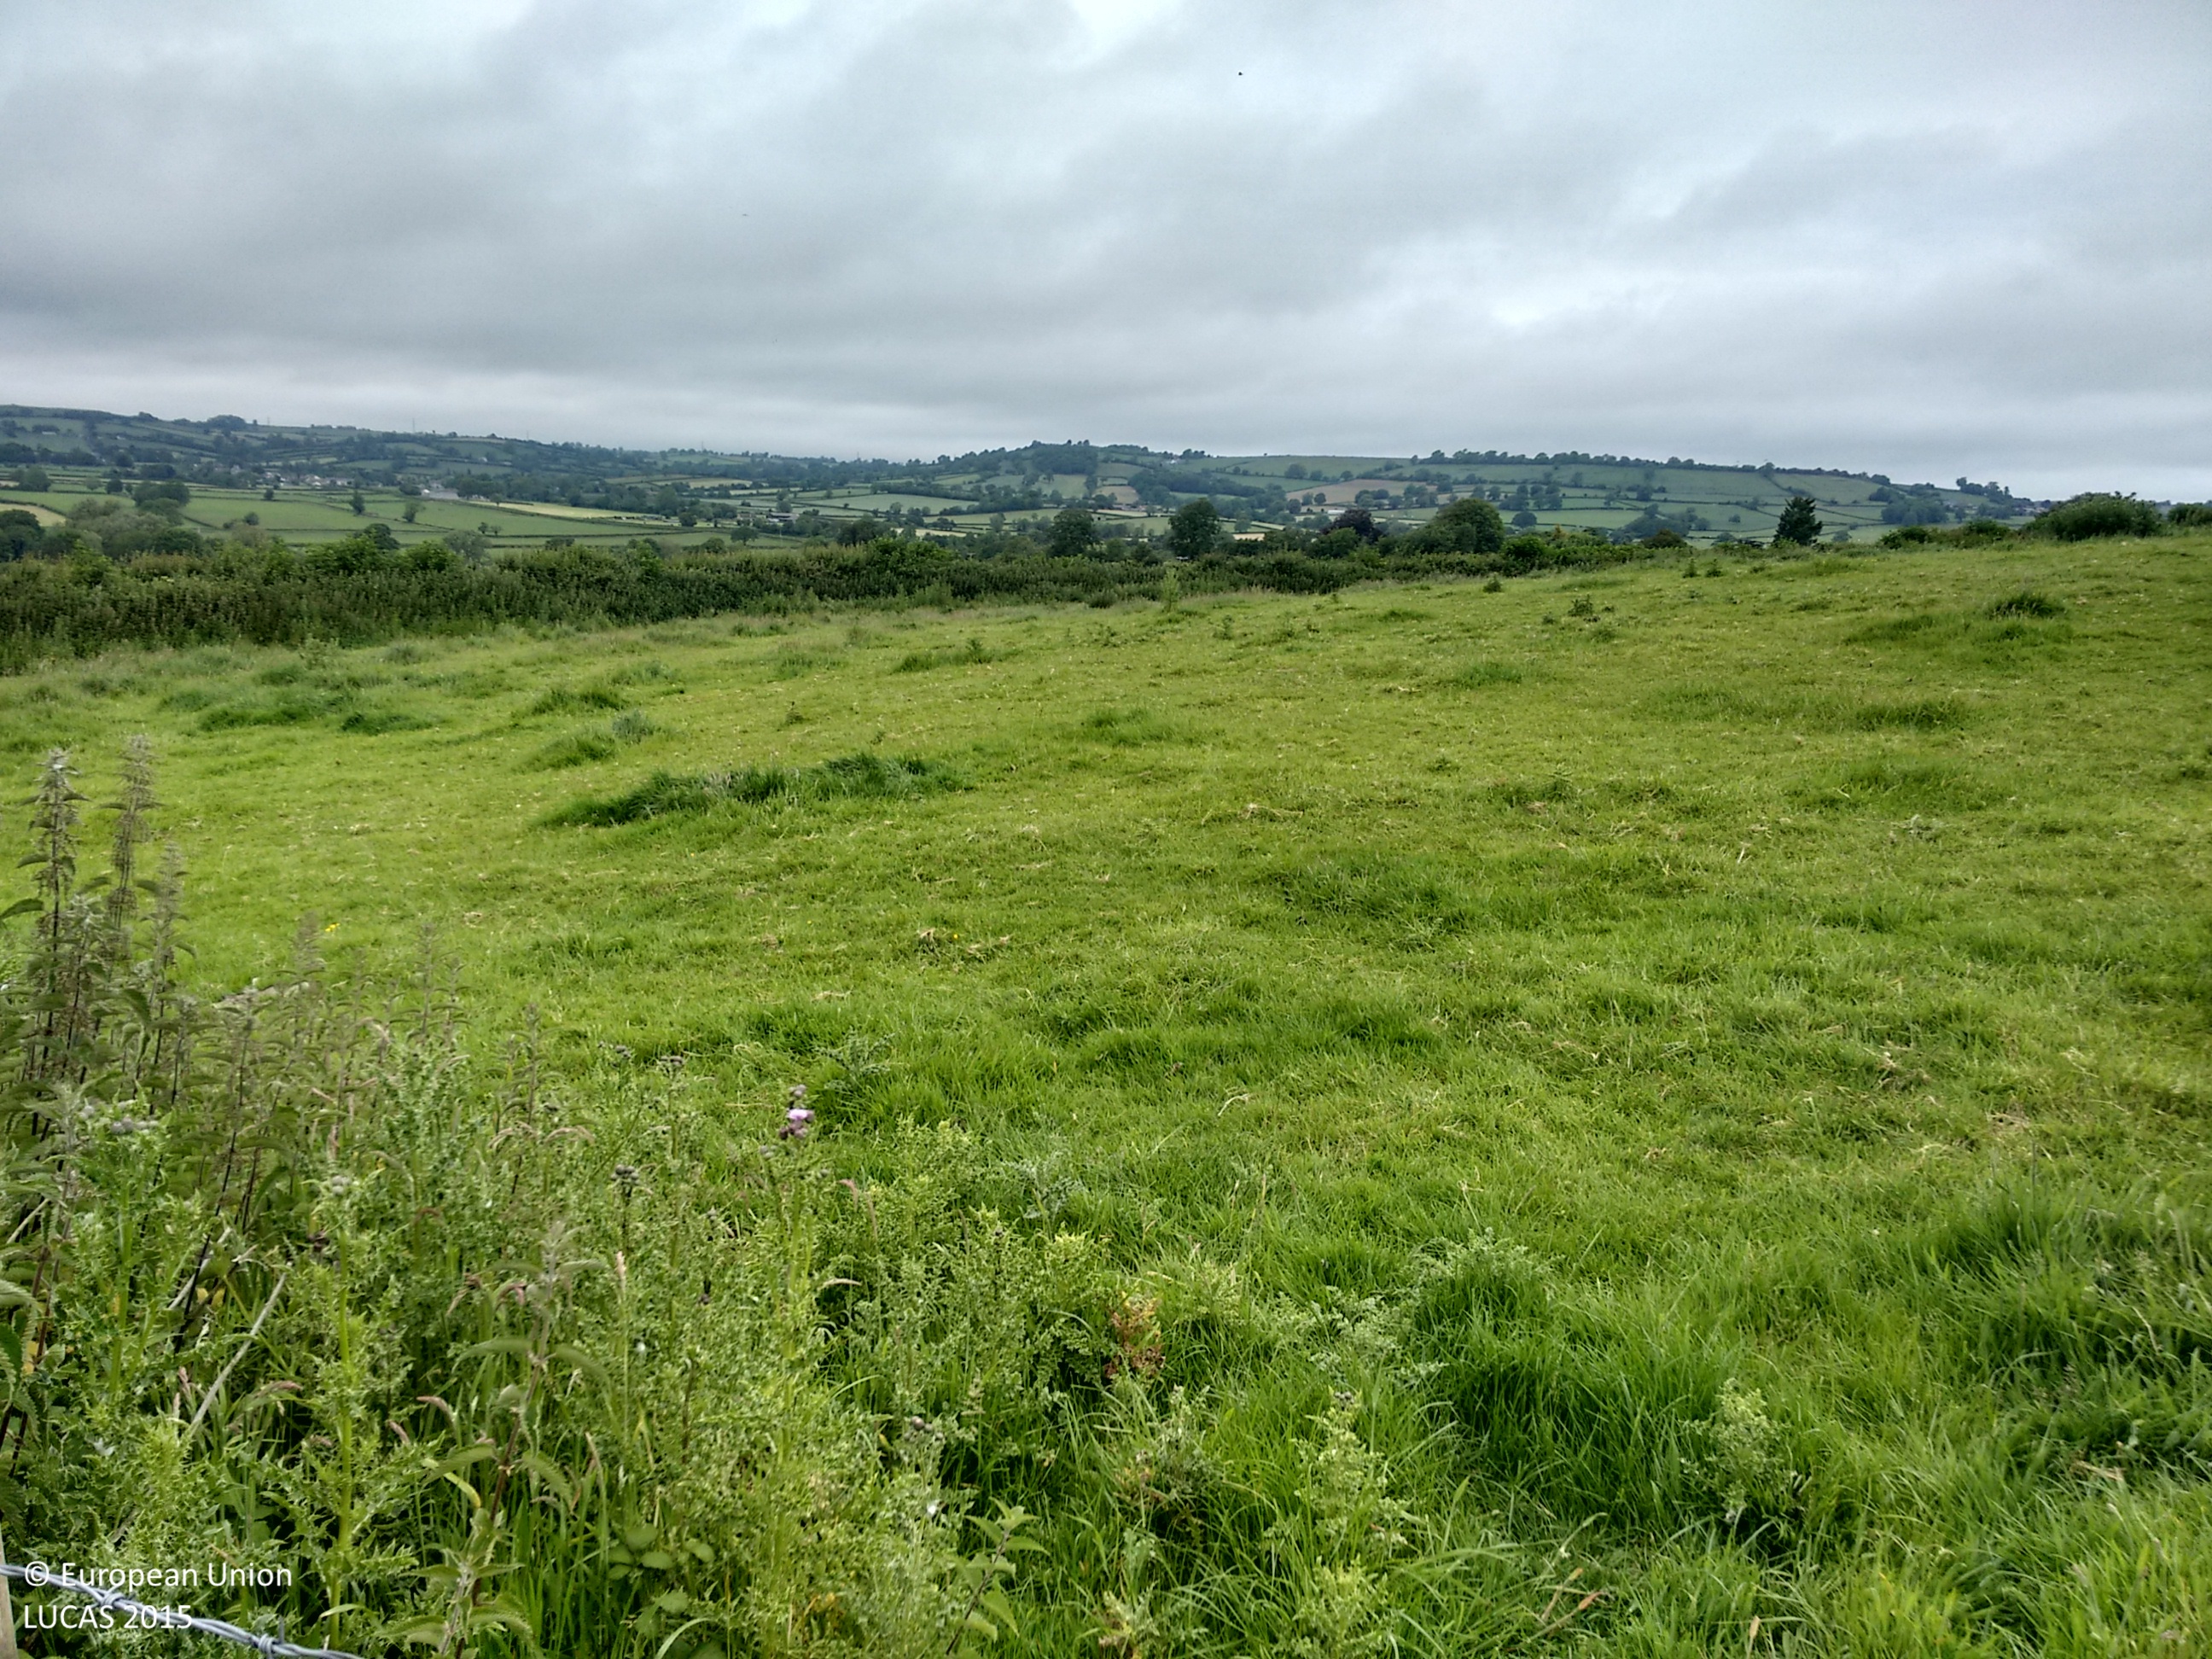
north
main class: Grassland
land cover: Grassland without tree/shrub cover
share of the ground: > 75 %
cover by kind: herbaceous plants 100 %
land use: Agriculture (excluding fallow land and kitchen gardens)
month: June
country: GB
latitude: 51.1328
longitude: -2.4847
